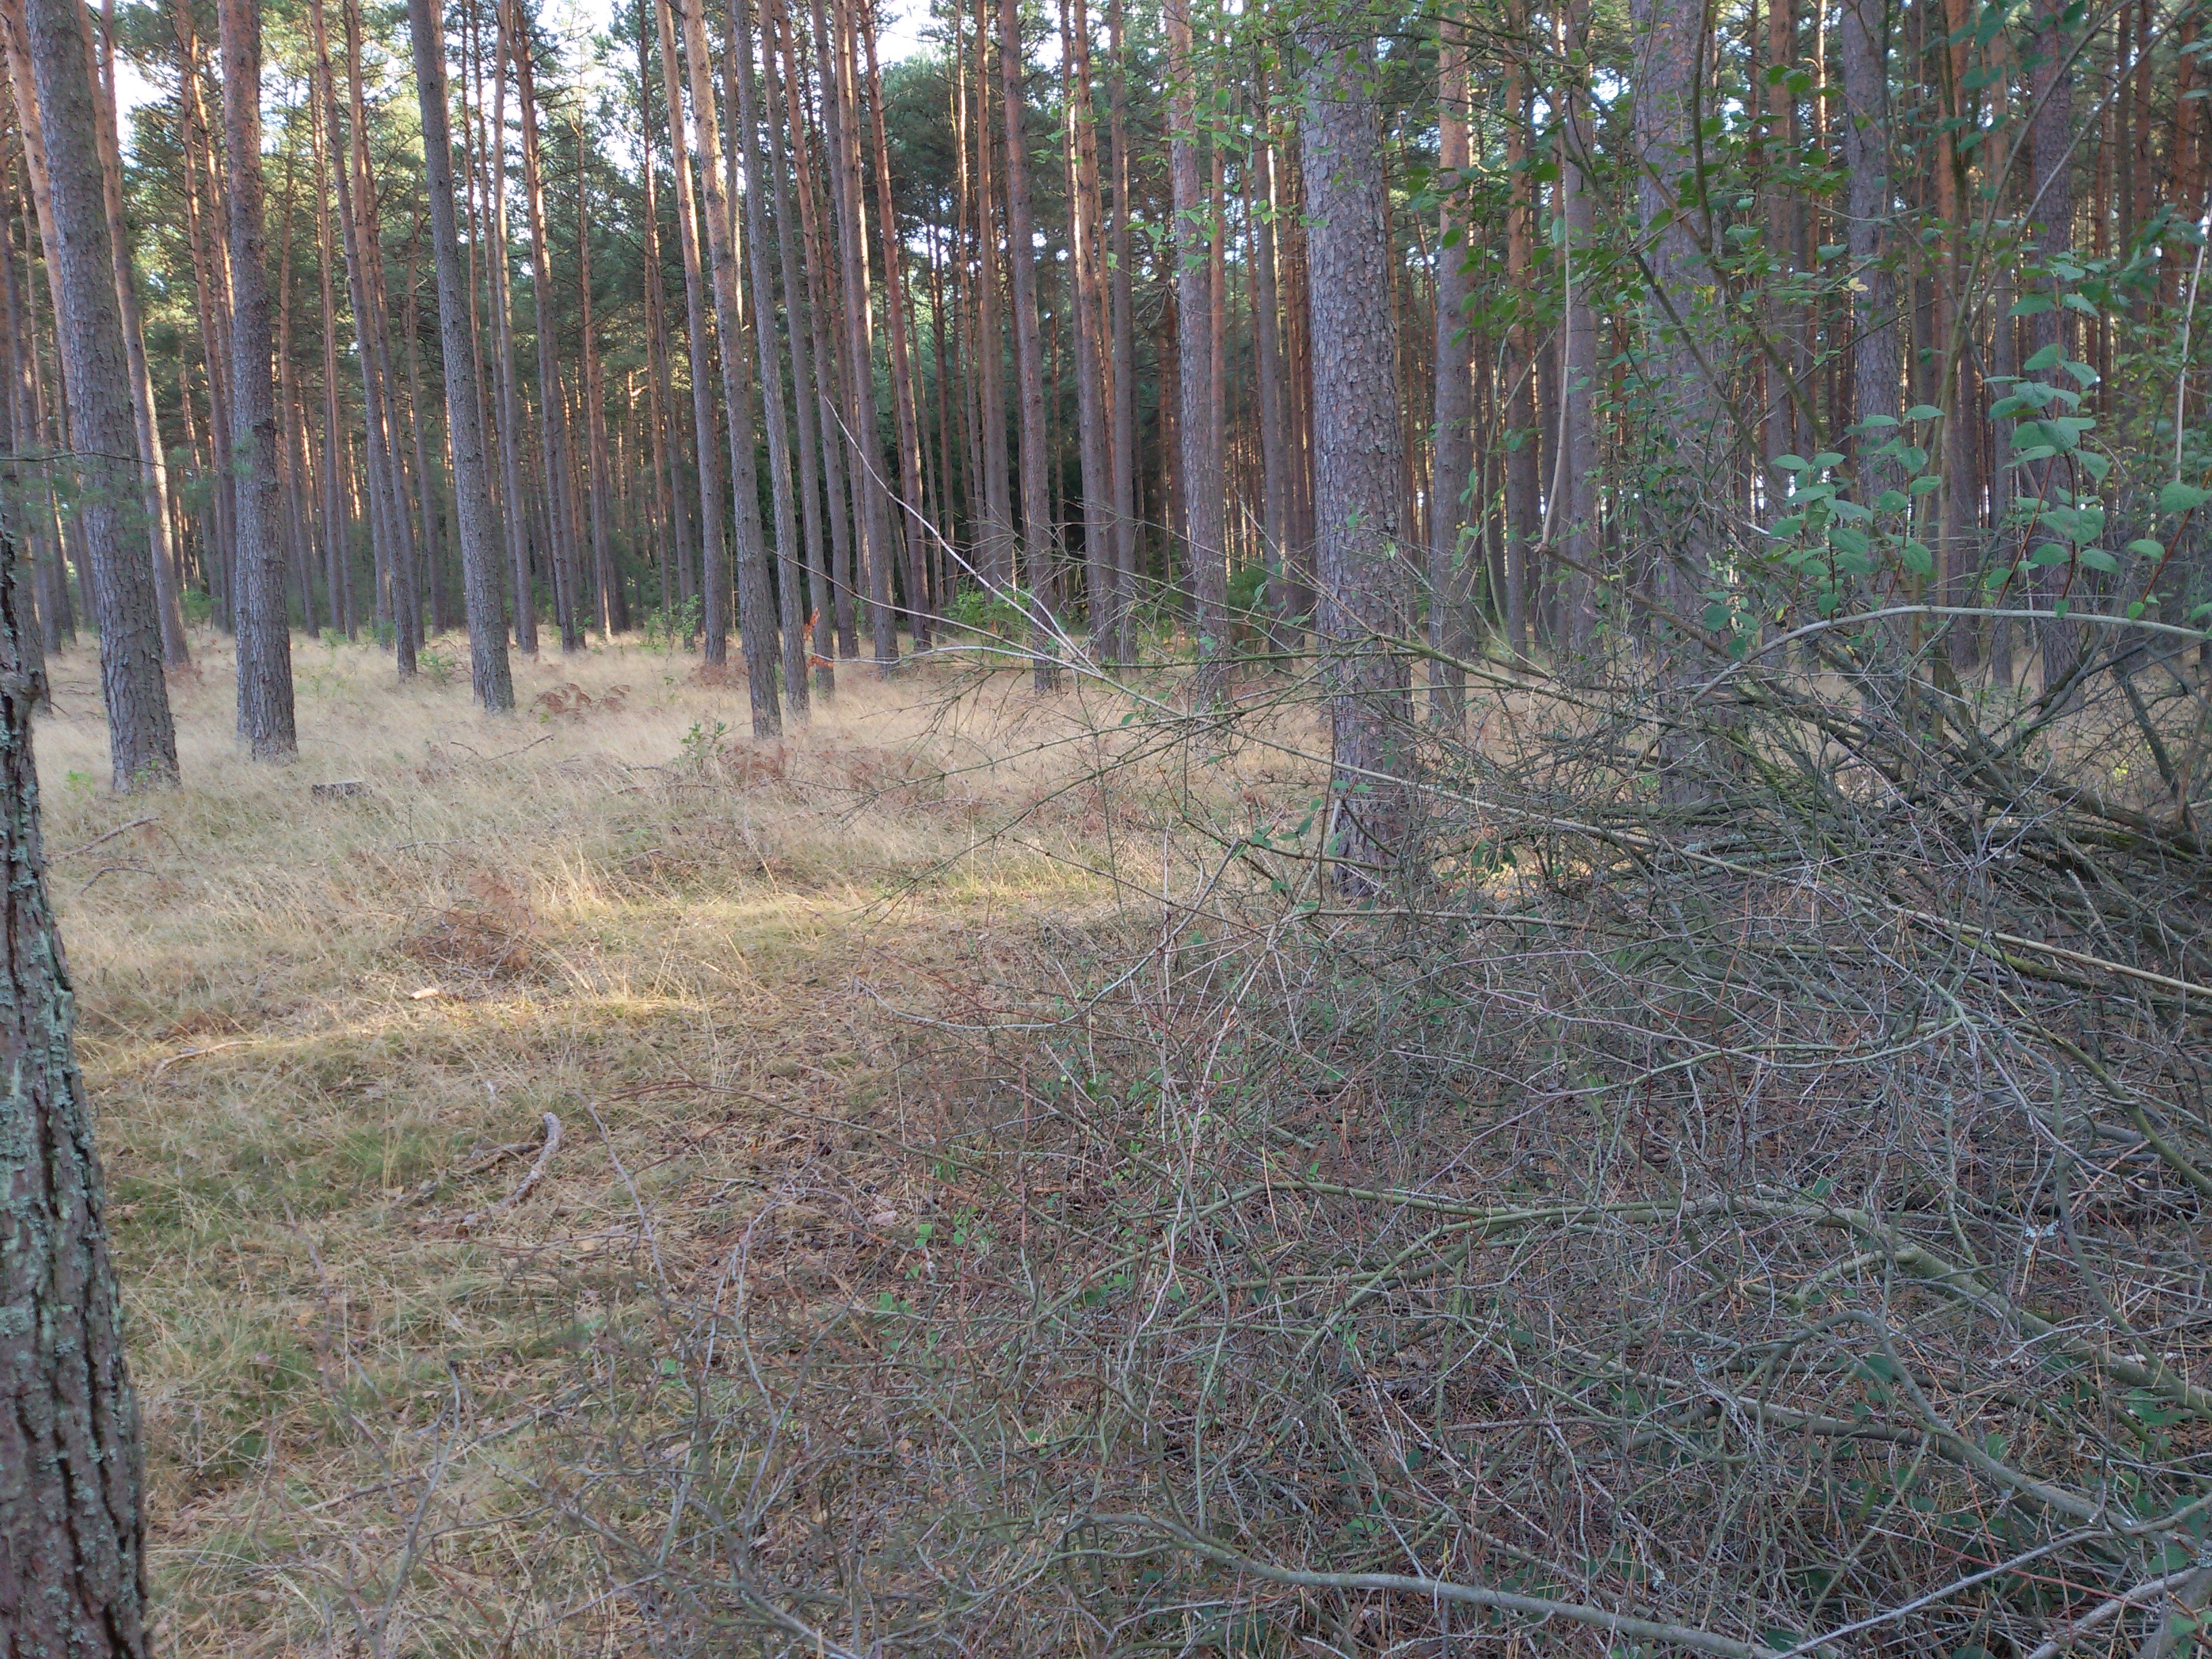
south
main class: Woodland
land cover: Pine dominated coniferous woodland
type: hemiboreal forest and nemoral coniferous forest and mixed broadleaved-coniferous forest
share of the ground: 50 - 75 %
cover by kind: coniferous forest trees 45 %, shrubs 25 %, herbaceous plants 15 %, broadleaved forest trees 10 %, lichens and mosses 5 %
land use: Forestry
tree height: > 5 m
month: September
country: PL
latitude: 53.0721
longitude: 17.6098
